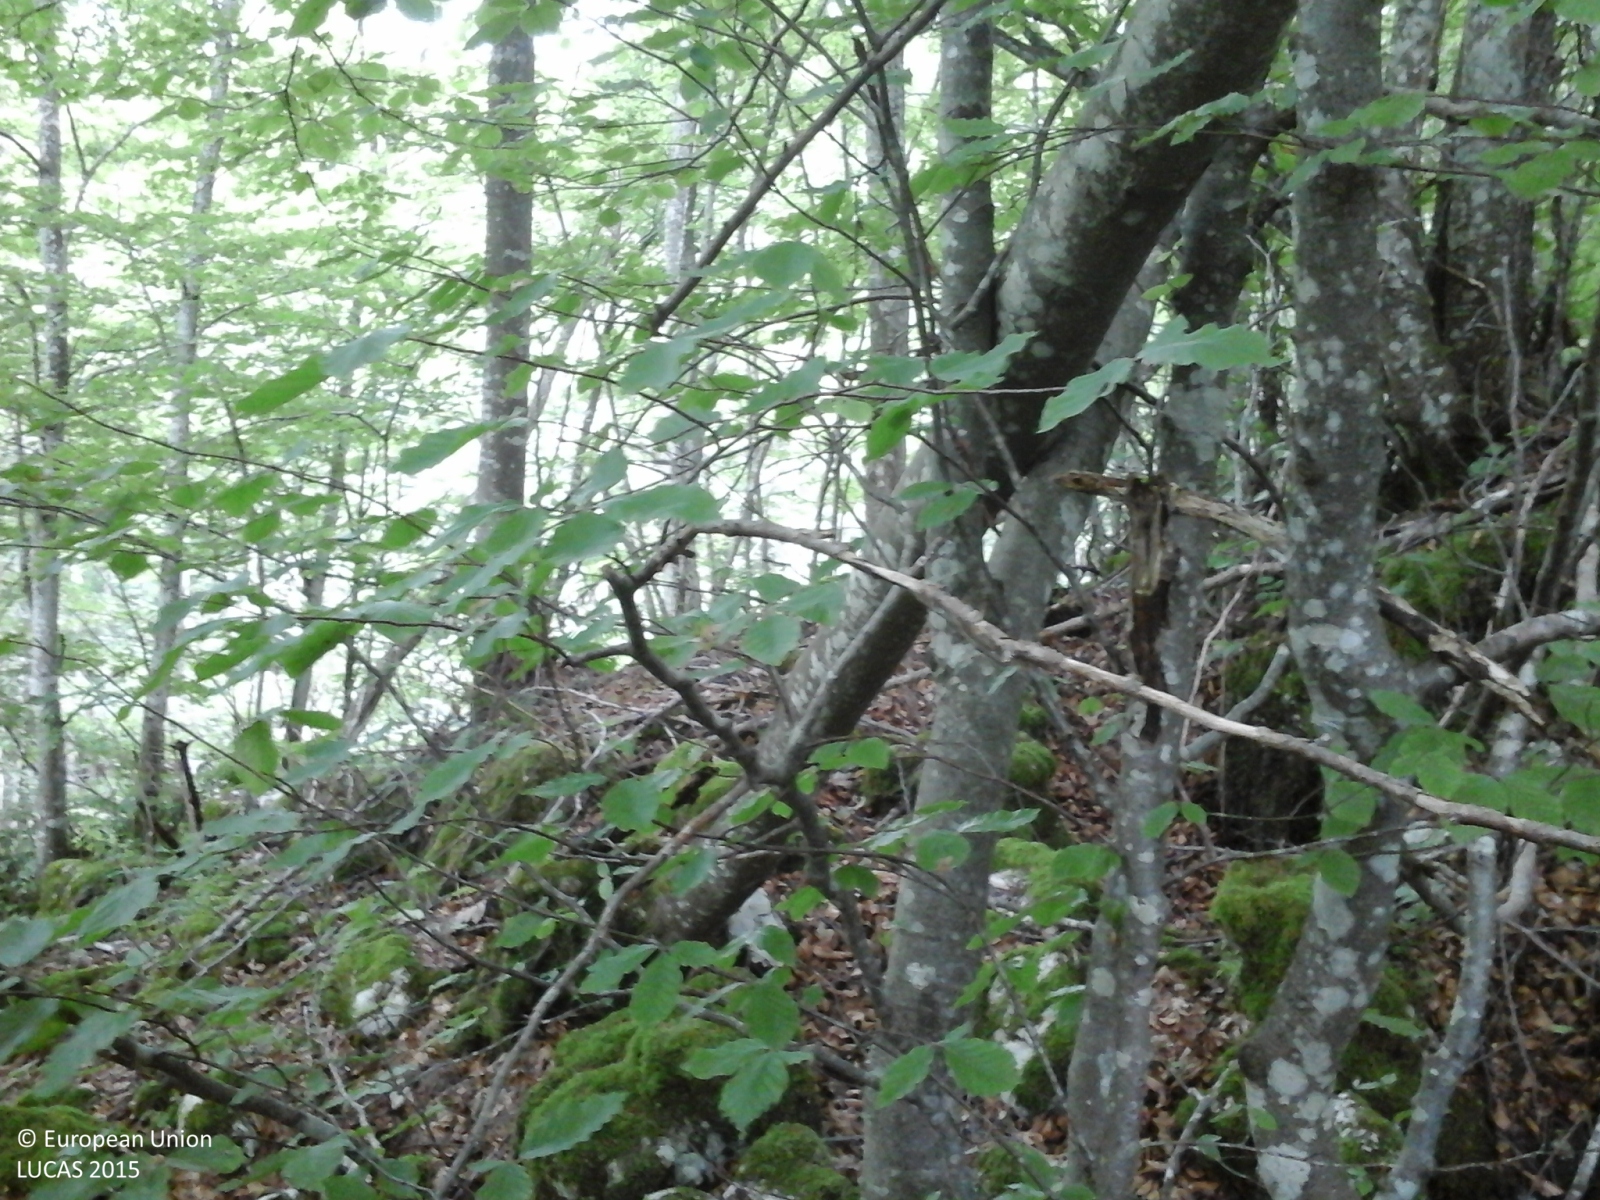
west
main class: Woodland
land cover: Broadleaved woodland
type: mountainous beech forest
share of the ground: > 75 %
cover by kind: broadleaved forest trees 100 %
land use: Forestry
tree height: > 5 m
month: June
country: IT
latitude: 45.8522
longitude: 11.6331
